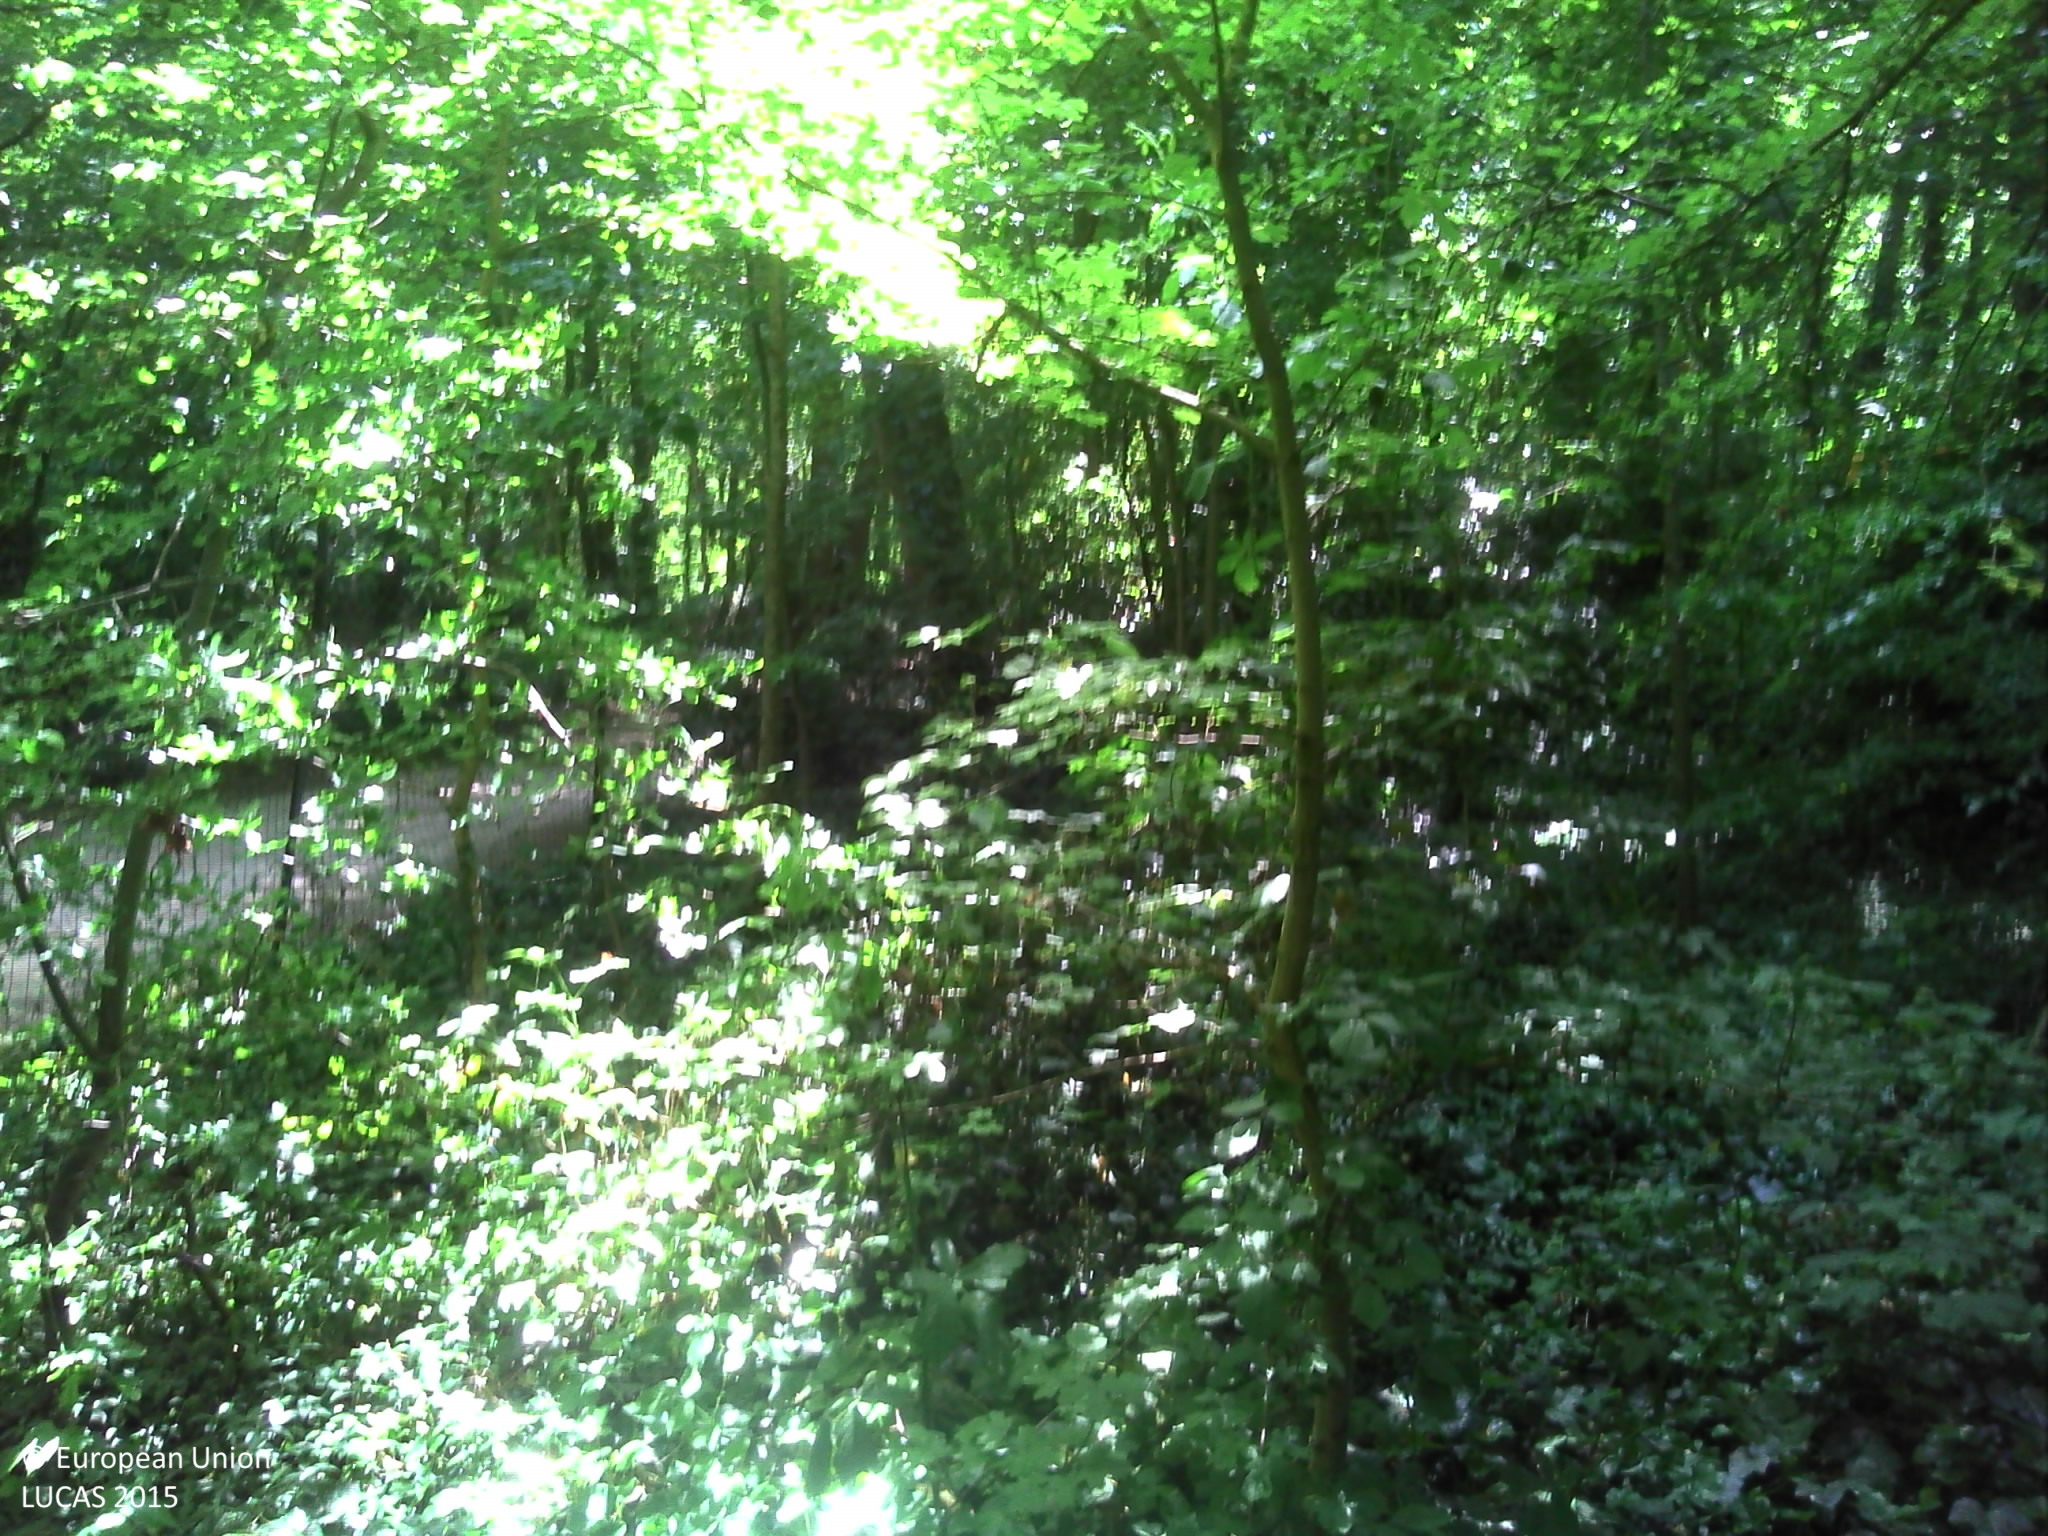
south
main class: Woodland
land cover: Broadleaved woodland
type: mesophytic deciduous forest
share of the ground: > 75 %
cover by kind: broadleaved forest trees 75 %, shrubs 20 %, herbaceous plants 5 %
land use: Amenities, museums, leisure
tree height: > 5 m
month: June
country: FR
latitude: 49.1515
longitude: -0.3311
